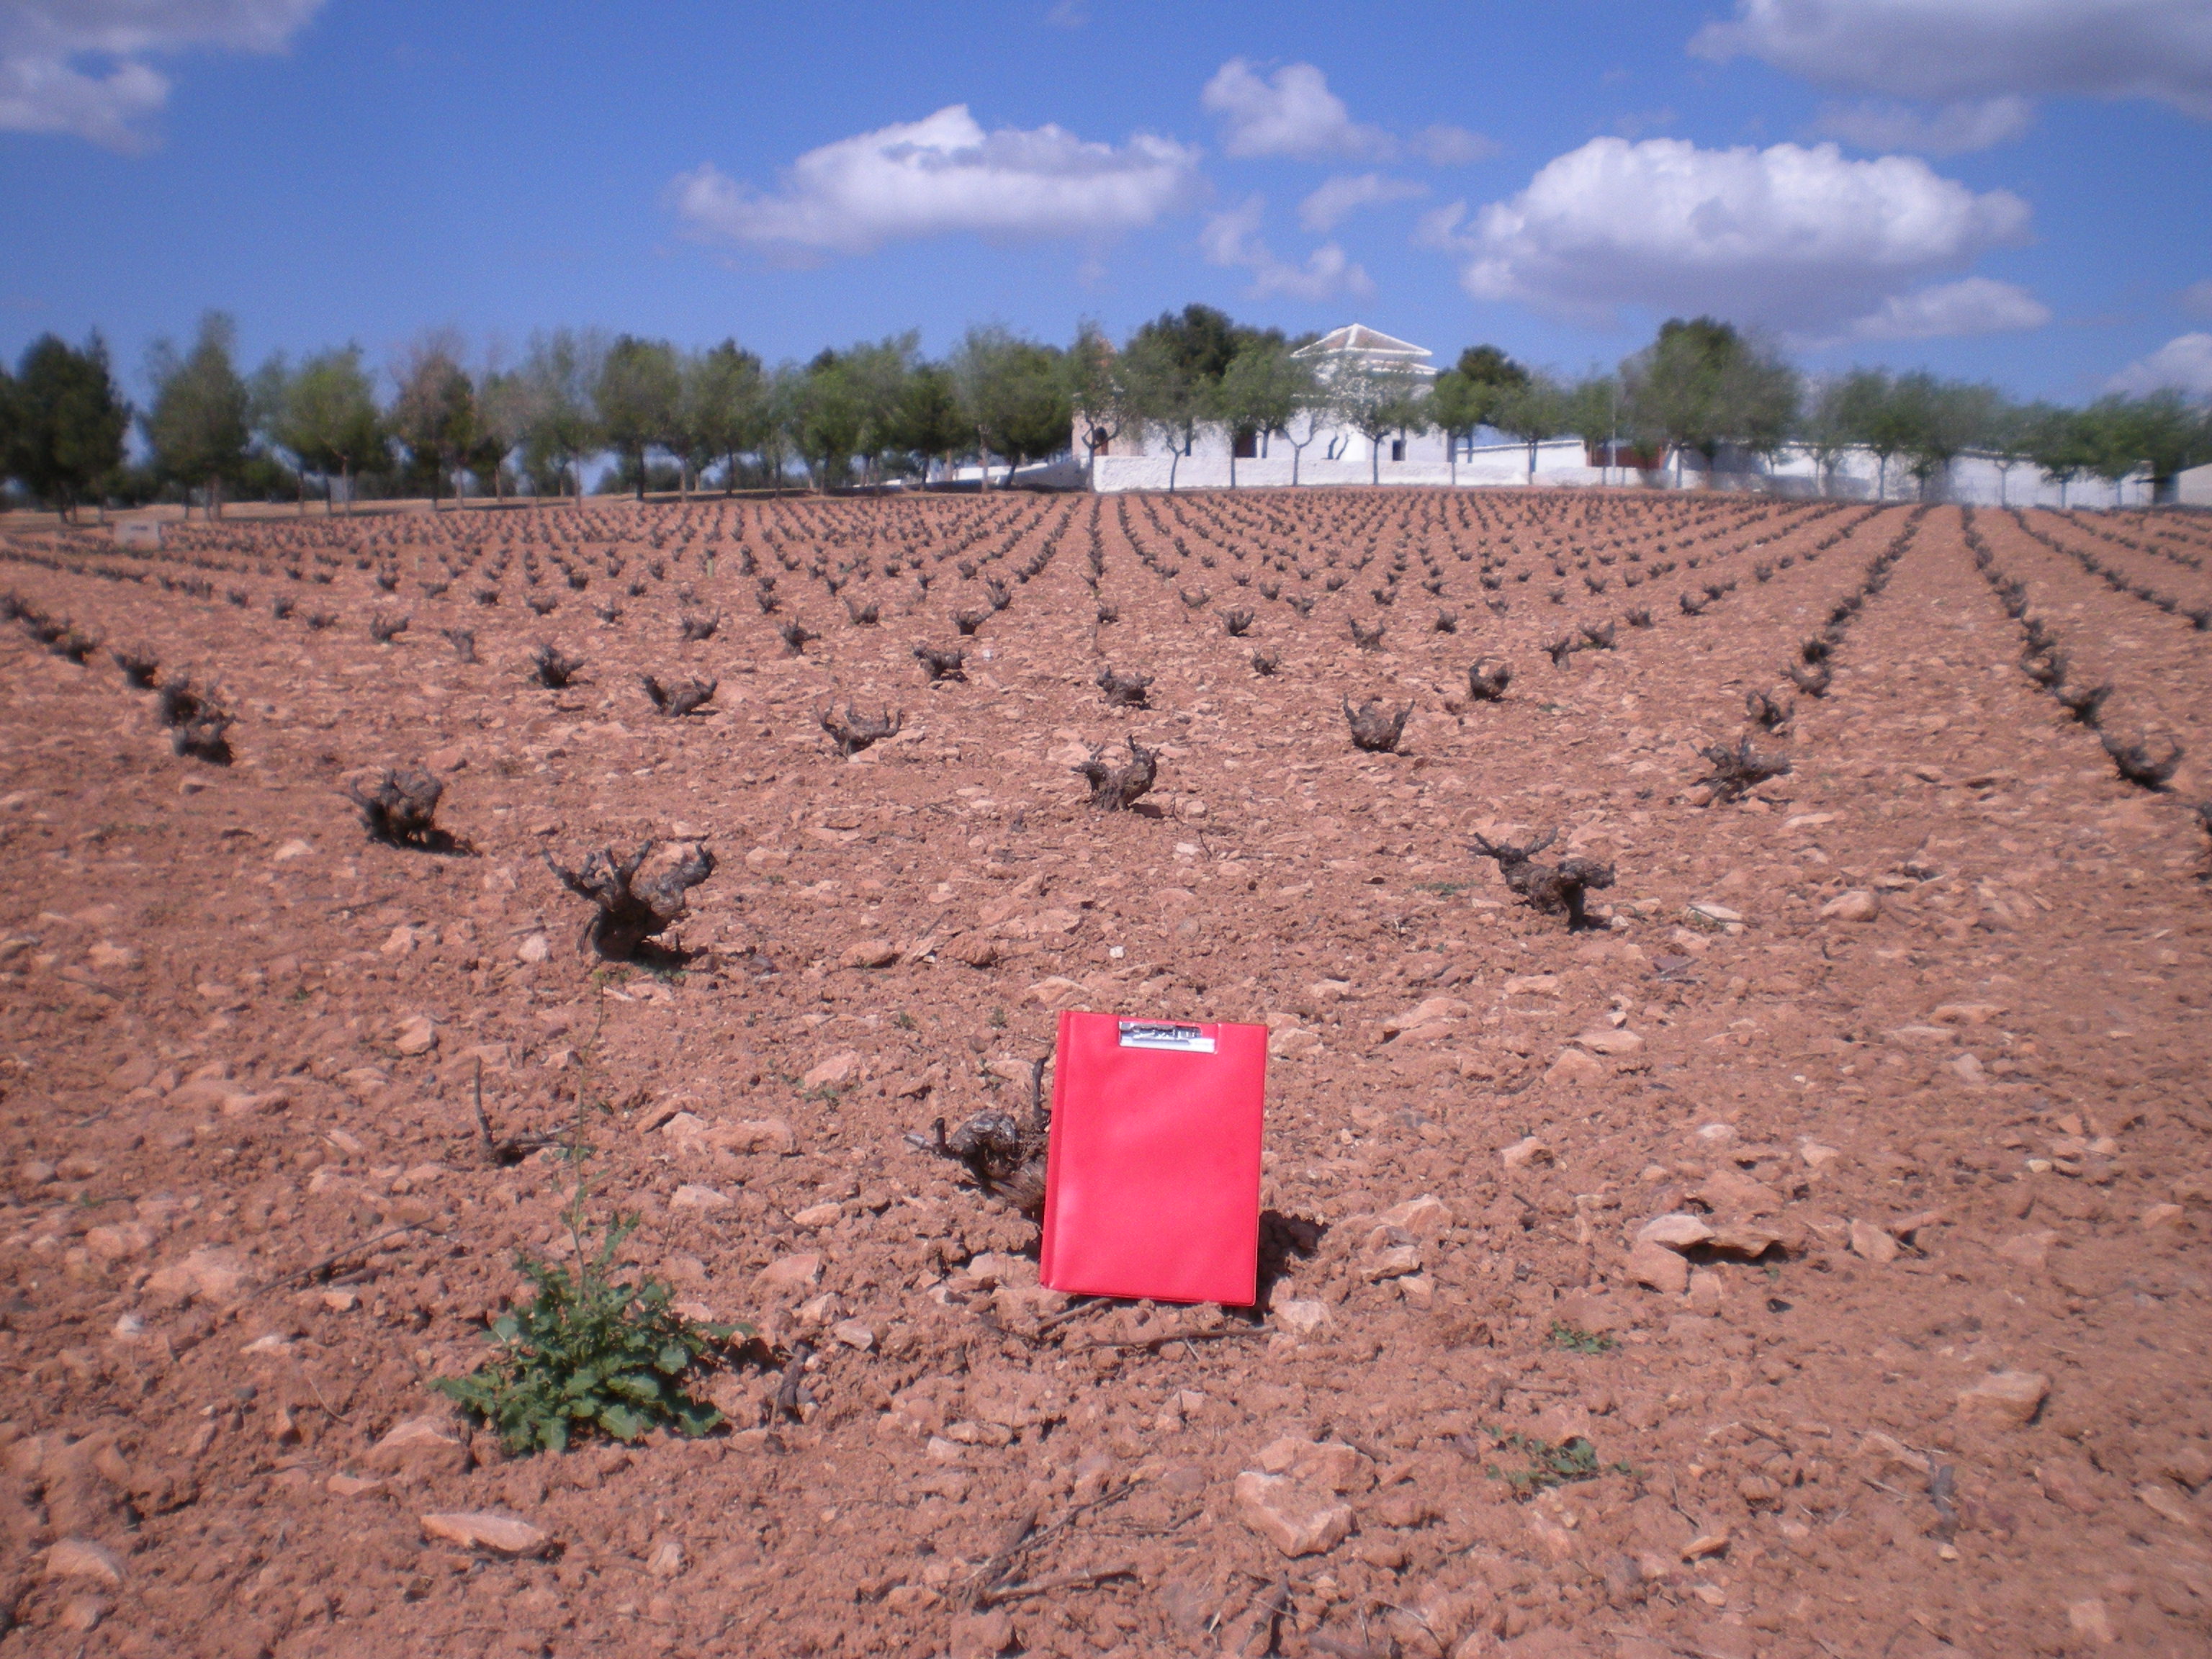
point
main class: Cropland
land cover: Vineyards
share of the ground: < 10 %
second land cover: Other bare soil
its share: > 75 %
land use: Agriculture (excluding fallow land and kitchen gardens)
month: April
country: ES
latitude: 38.7891
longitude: -3.5637
